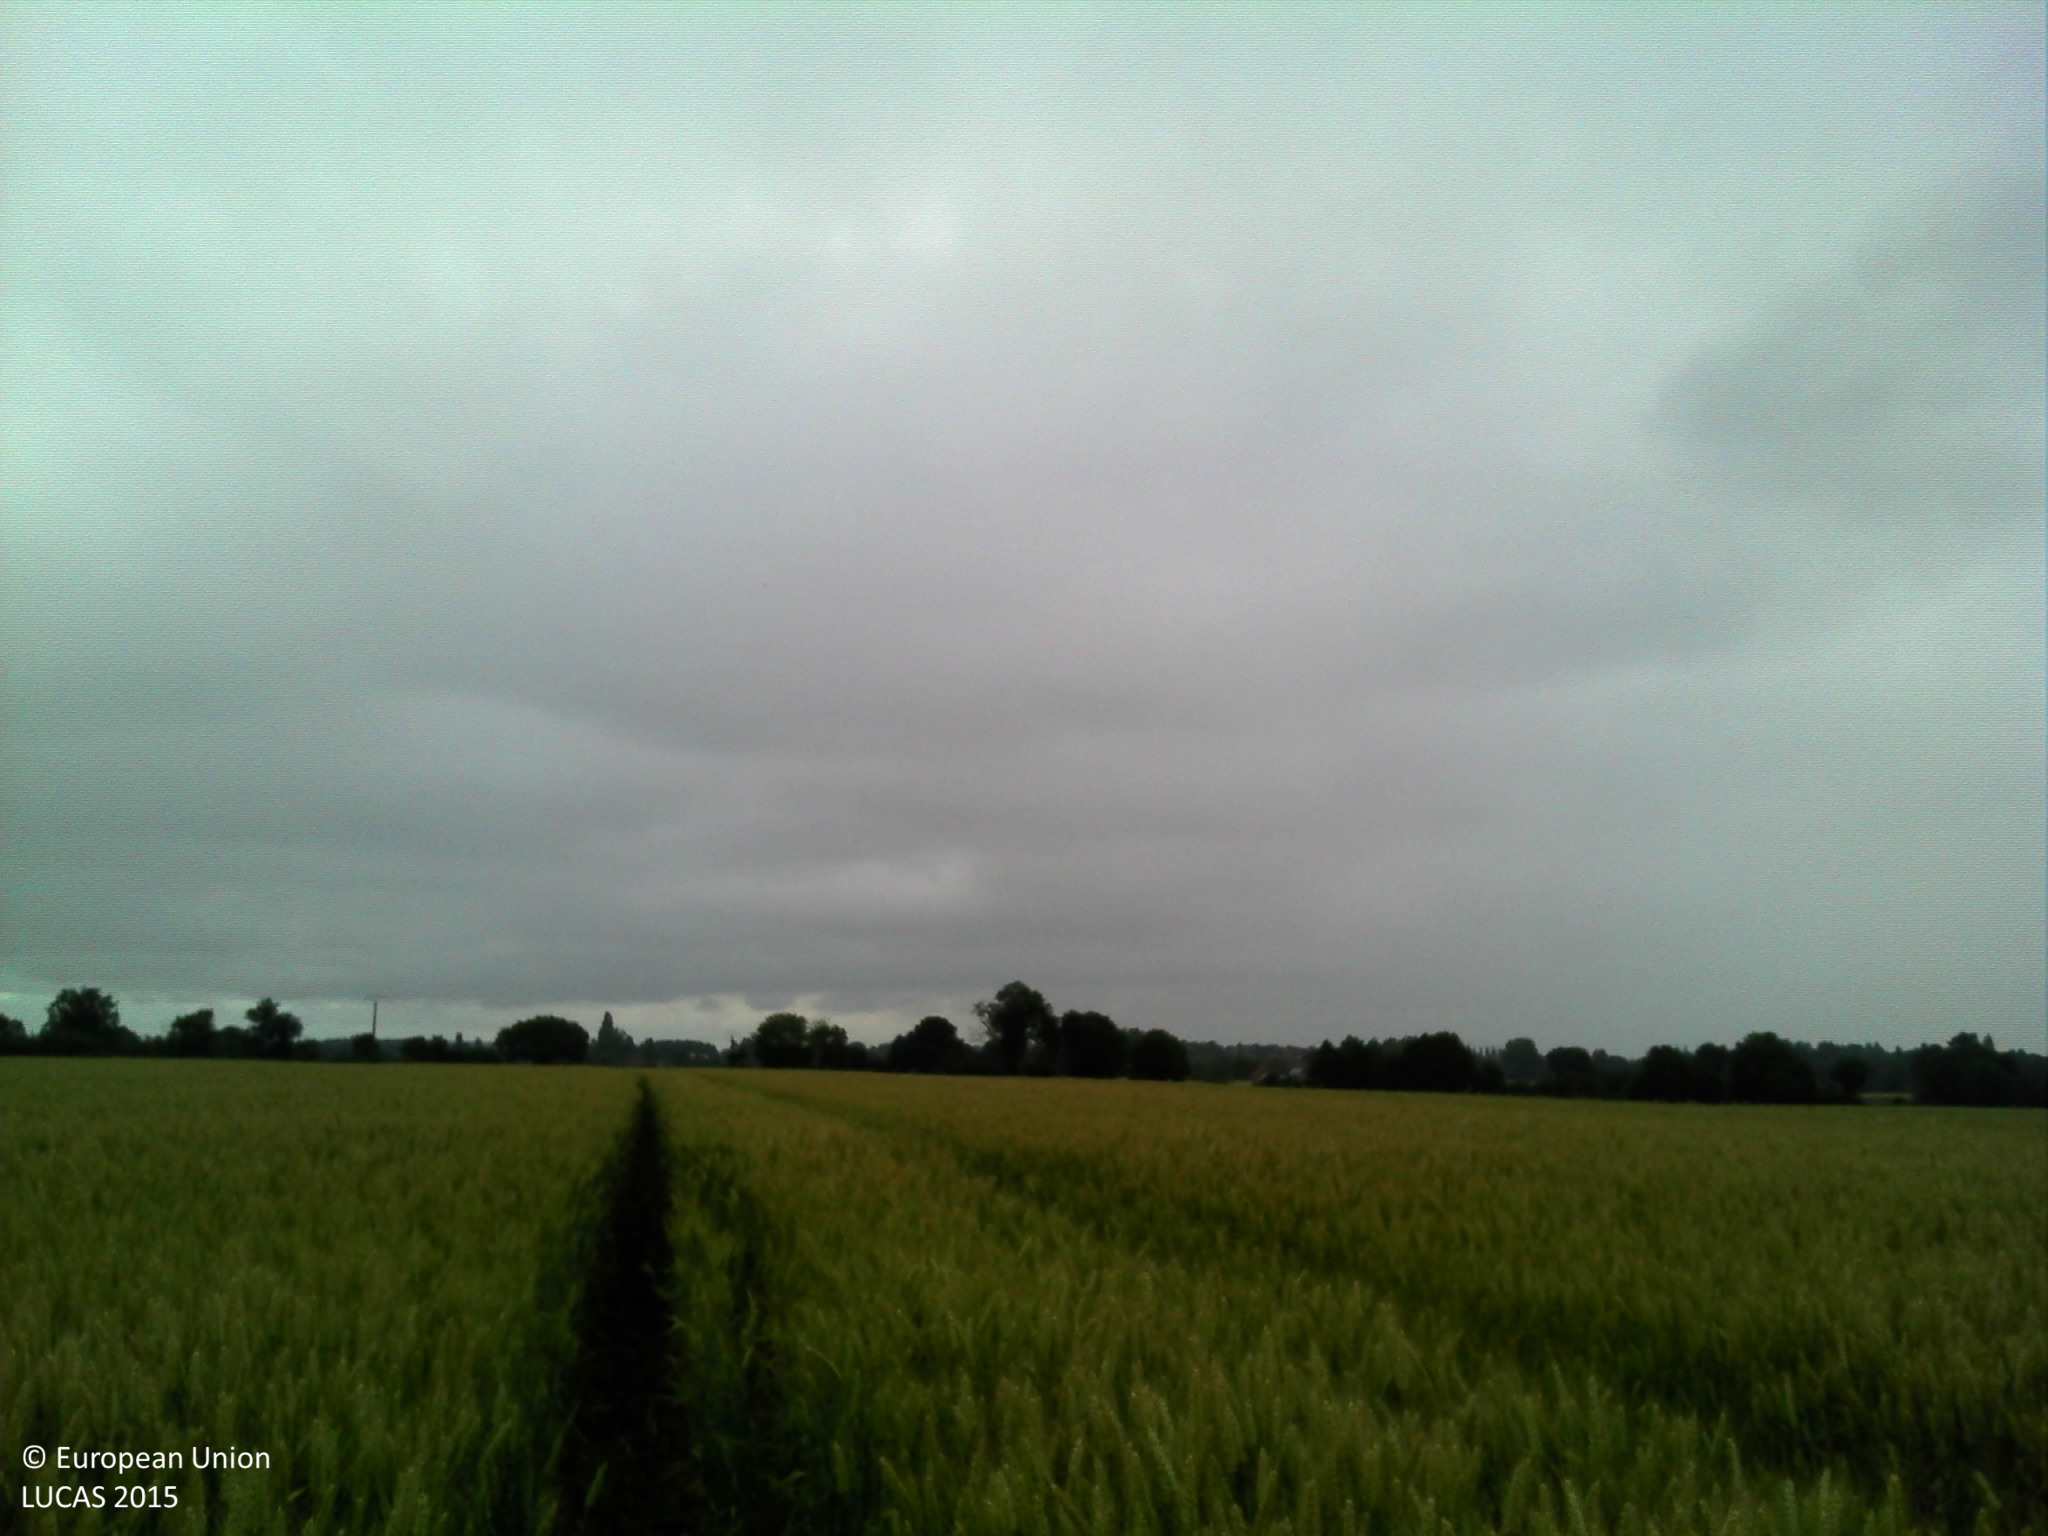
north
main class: Cropland
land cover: Common wheat
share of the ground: > 75 %
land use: Agriculture (excluding fallow land and kitchen gardens)
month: June
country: FR
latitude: 48.1284
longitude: 0.1786
